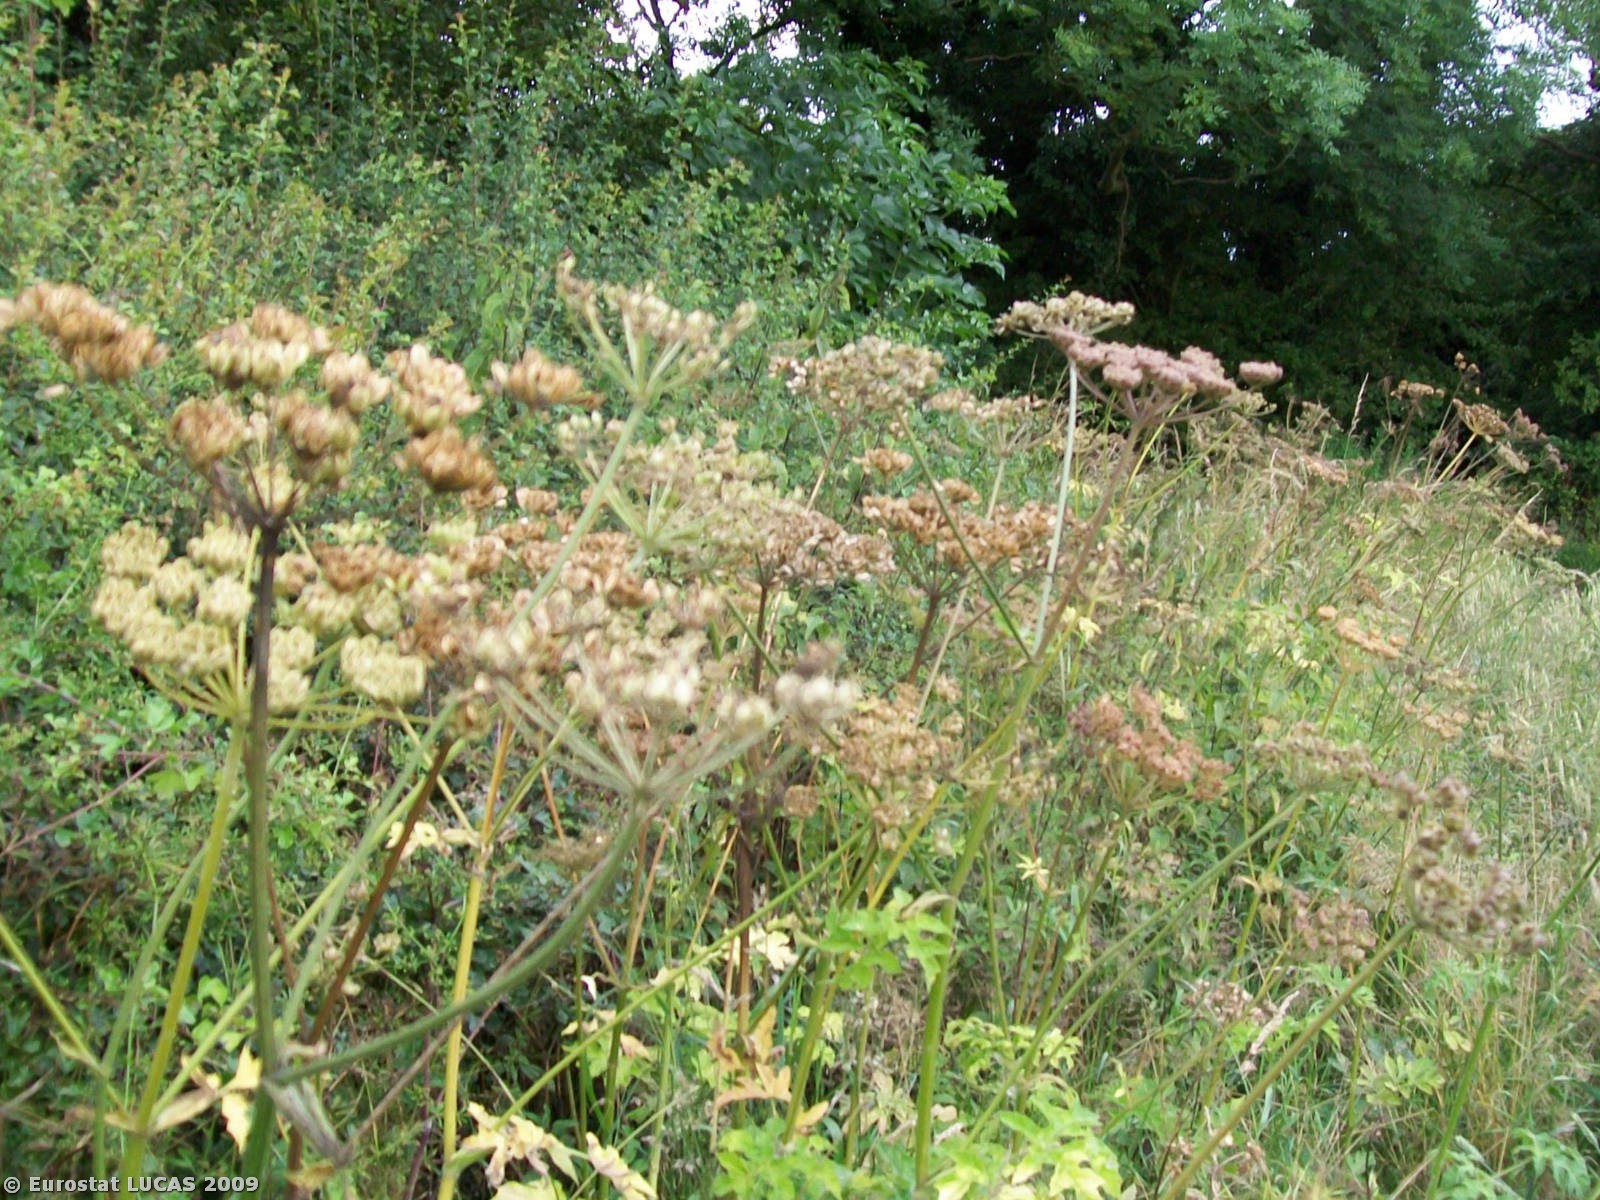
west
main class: Cropland
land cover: Common wheat
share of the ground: > 75 %
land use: Agriculture (excluding fallow land and kitchen gardens)
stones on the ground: < 10 %
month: July
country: GB
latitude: 52.6329
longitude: -1.3220
